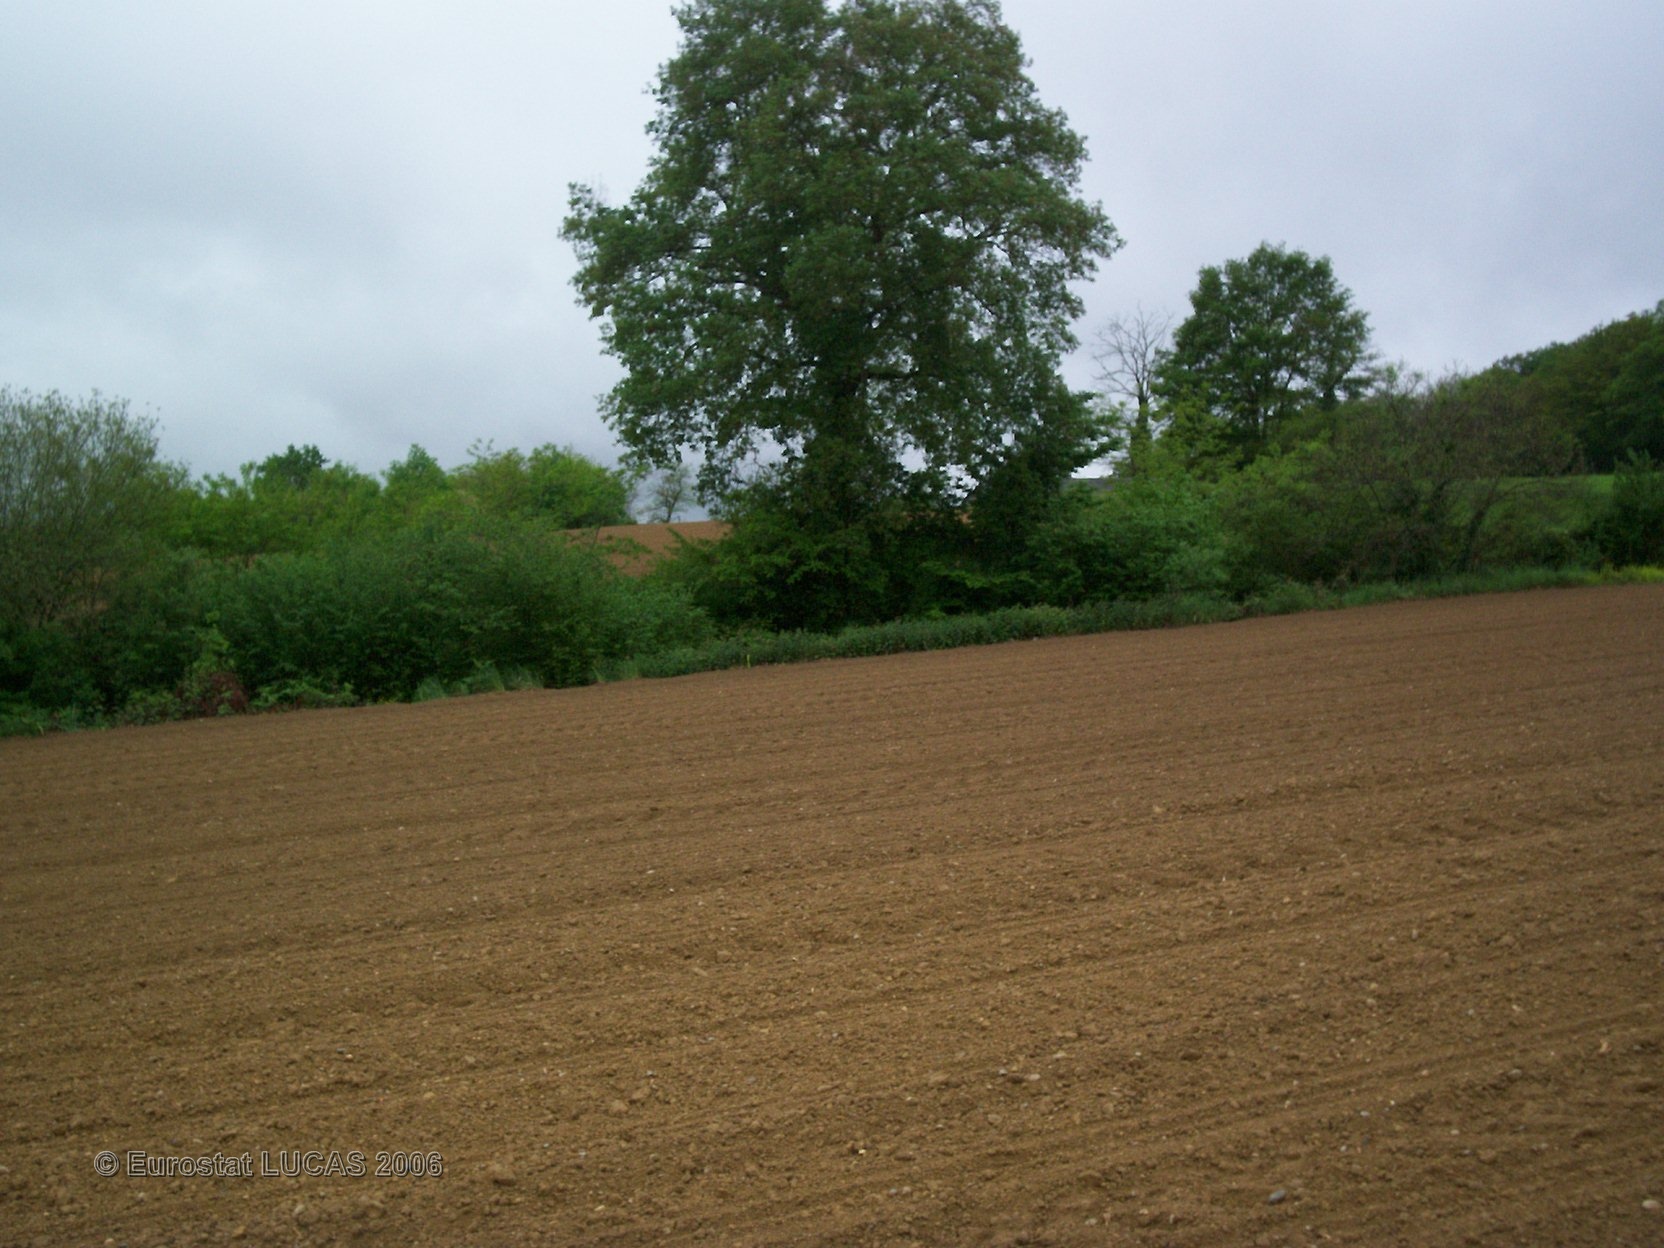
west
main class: Cropland
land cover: Maize
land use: Agriculture (excluding fallow land and kitchen gardens)
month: April
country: FR
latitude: 43.6488
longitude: -0.3614
